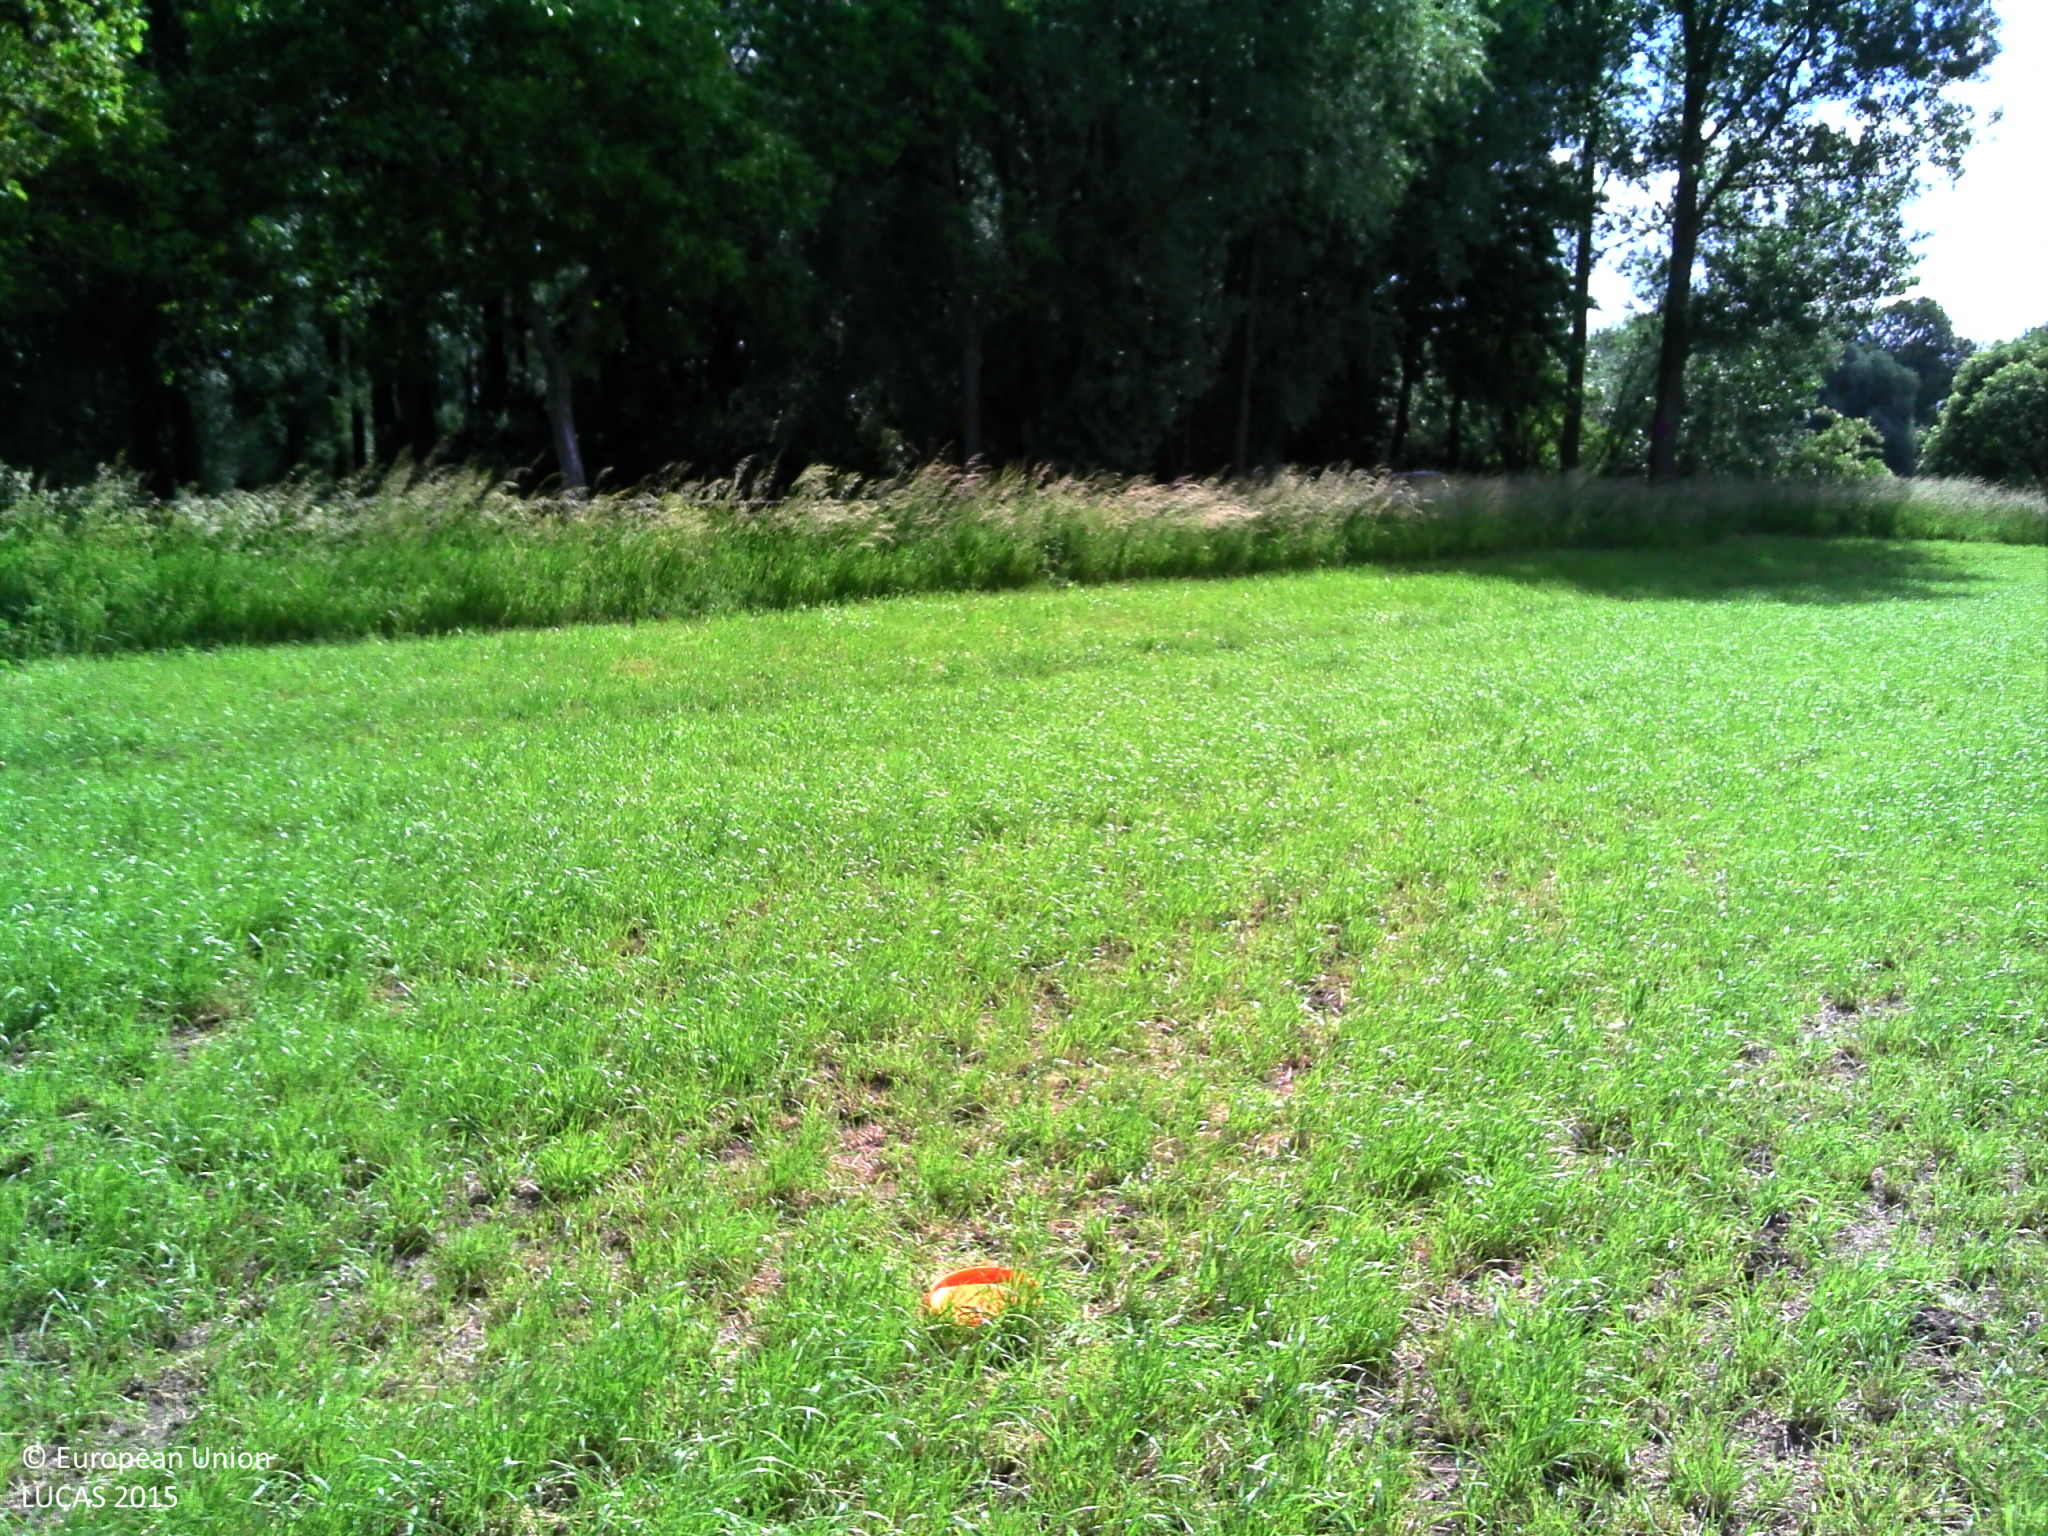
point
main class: Cropland
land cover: Temporary grasslands
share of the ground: > 75 %
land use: Agriculture (excluding fallow land and kitchen gardens)
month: June
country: BE
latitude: 50.9651
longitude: 3.6851
